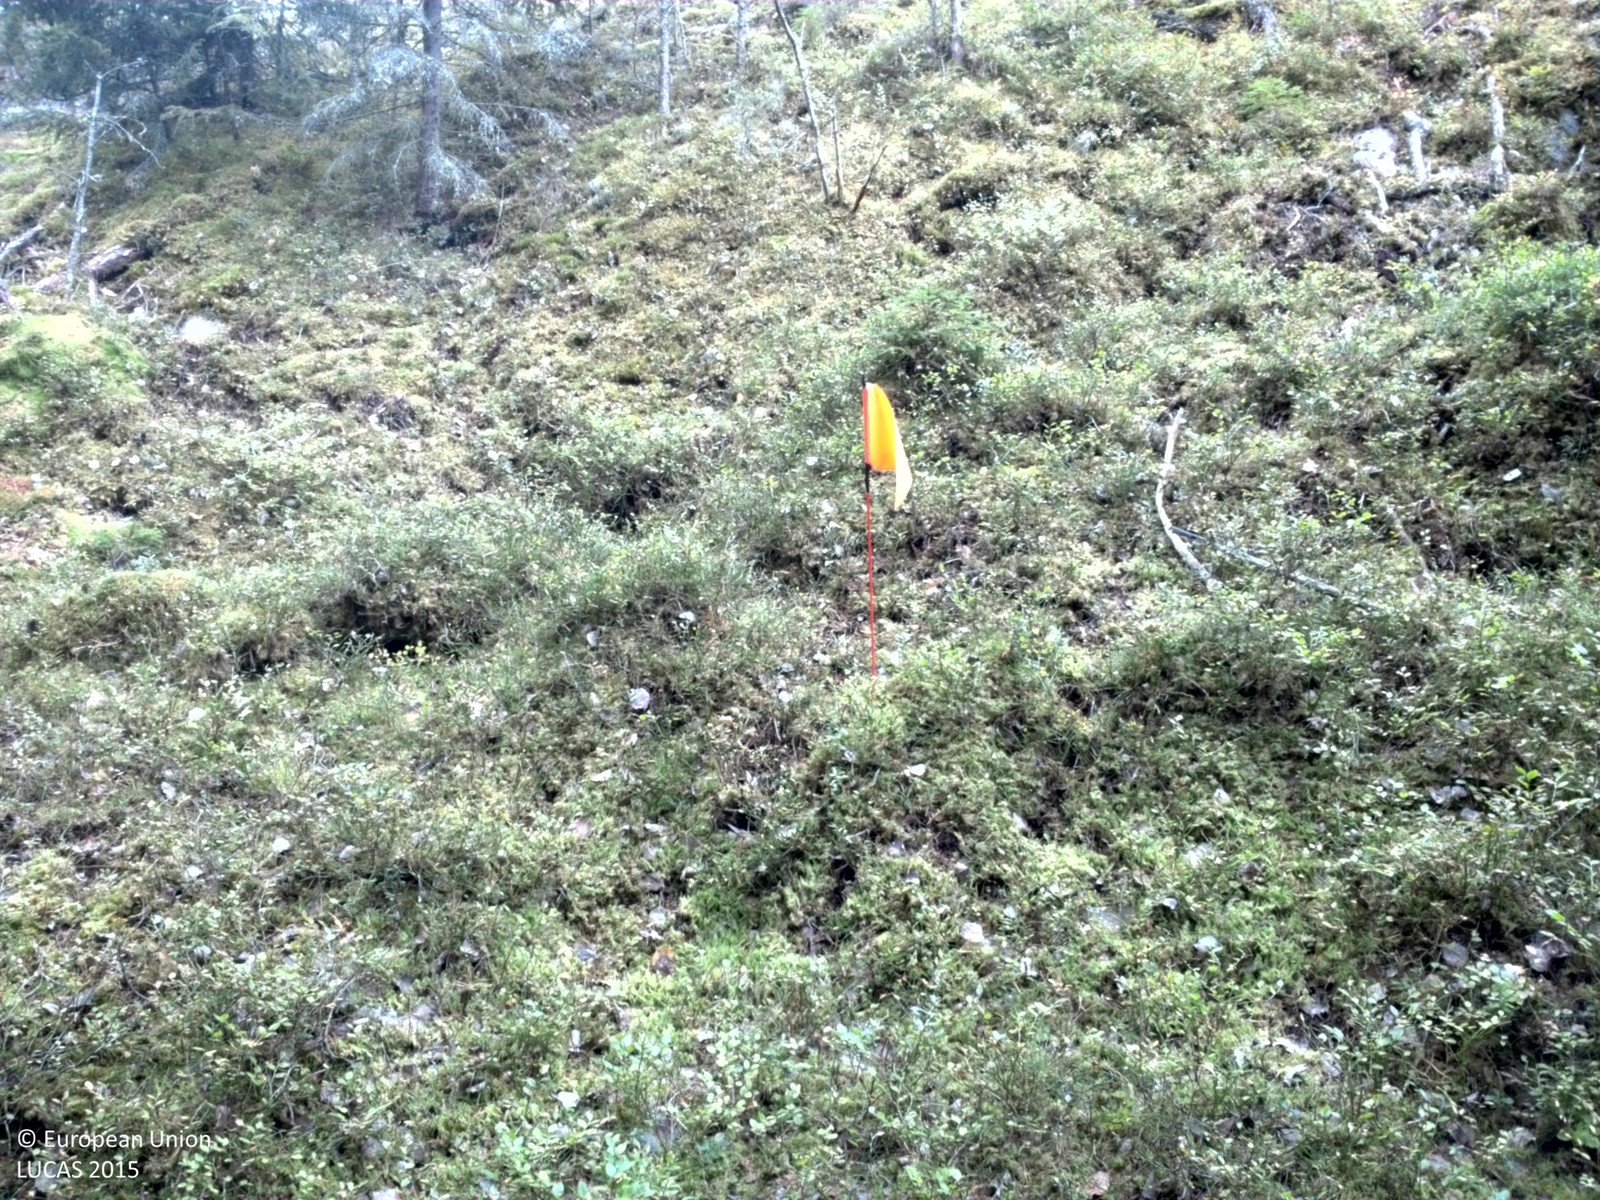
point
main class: Woodland
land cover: Pine dominated coniferous woodland
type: boreal forest
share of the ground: 50 - 75 %
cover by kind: coniferous forest trees 65 %, lichens and mosses 35 %
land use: Forestry
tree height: > 5 m
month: September
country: SE
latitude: 59.3781
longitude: 18.5373
